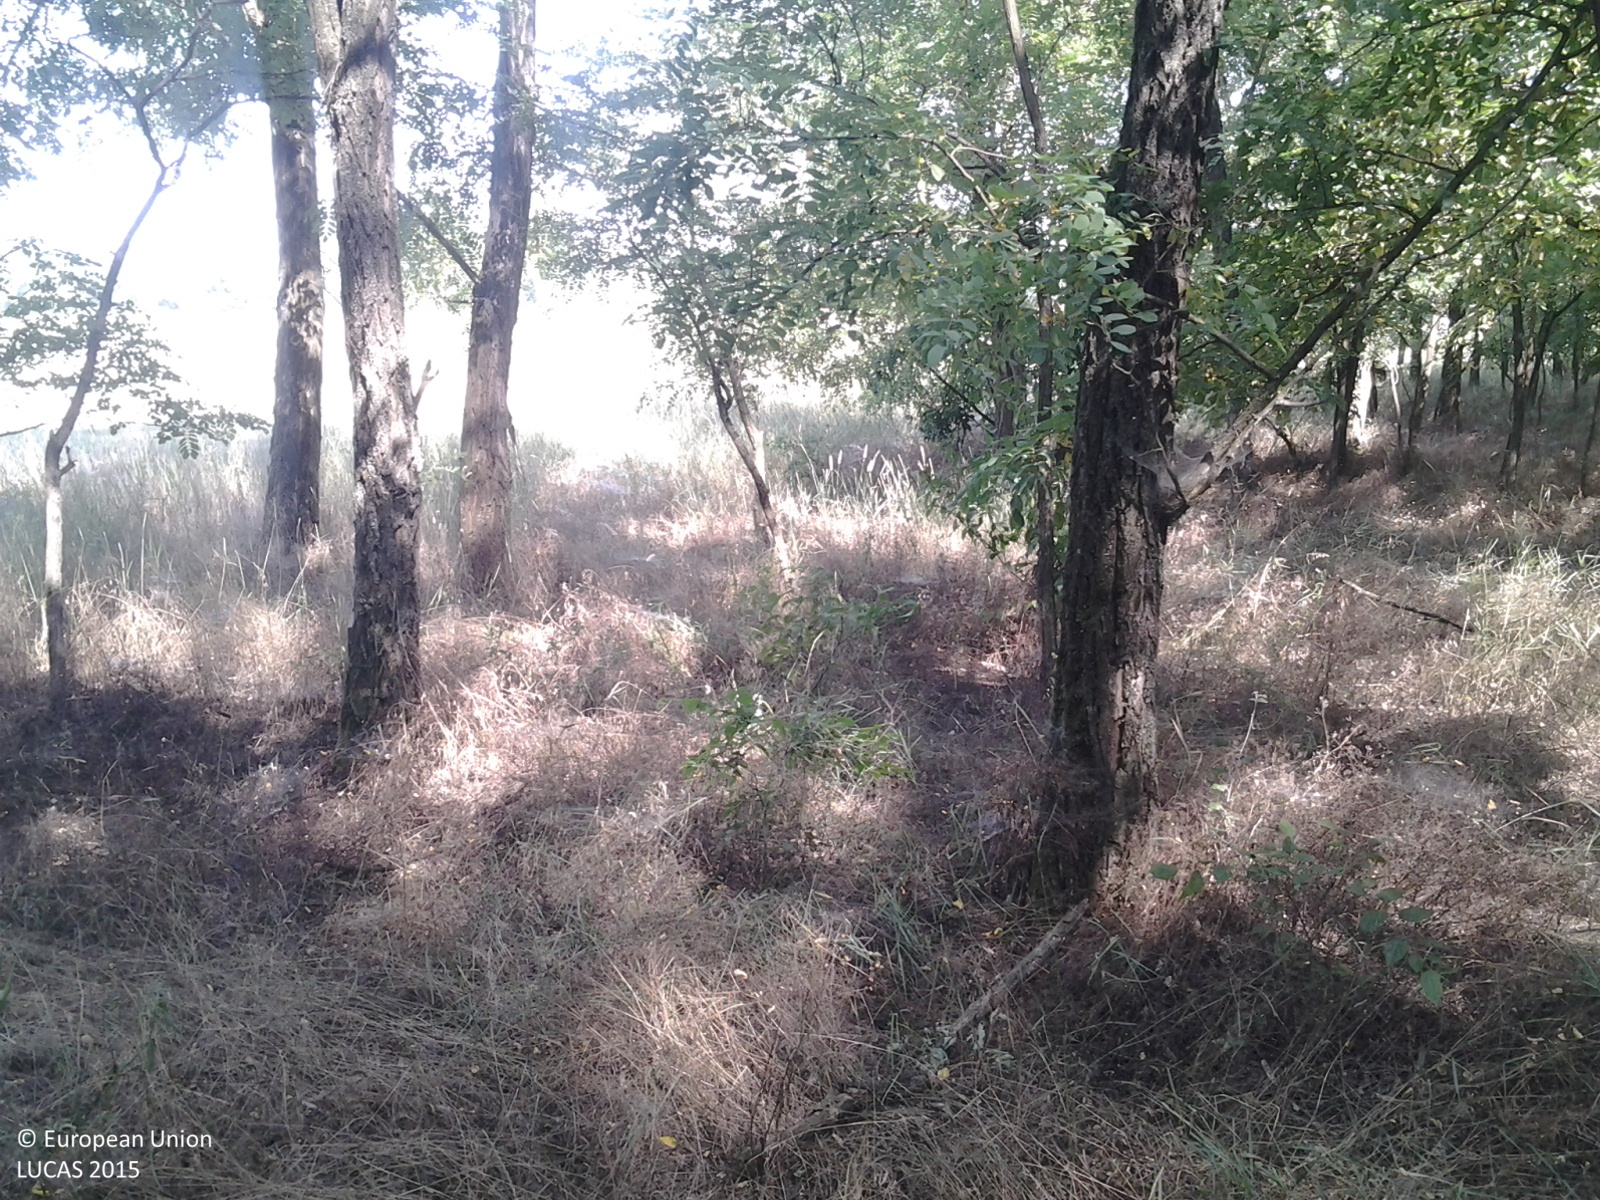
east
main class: Woodland
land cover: Broadleaved woodland
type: mesophytic deciduous forest
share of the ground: 50 - 75 %
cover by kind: broadleaved forest trees 70 %, herbaceous plants 30 %
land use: Forestry
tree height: > 5 m
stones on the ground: < 10 %
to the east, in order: Broadleaved woodland; Grass margins; Tracks; Grass margins; Mixed cereals for fodder; Tracks; Spontaneously vegetated surfaces
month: July
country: HU
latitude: 47.4346
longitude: 19.8758
